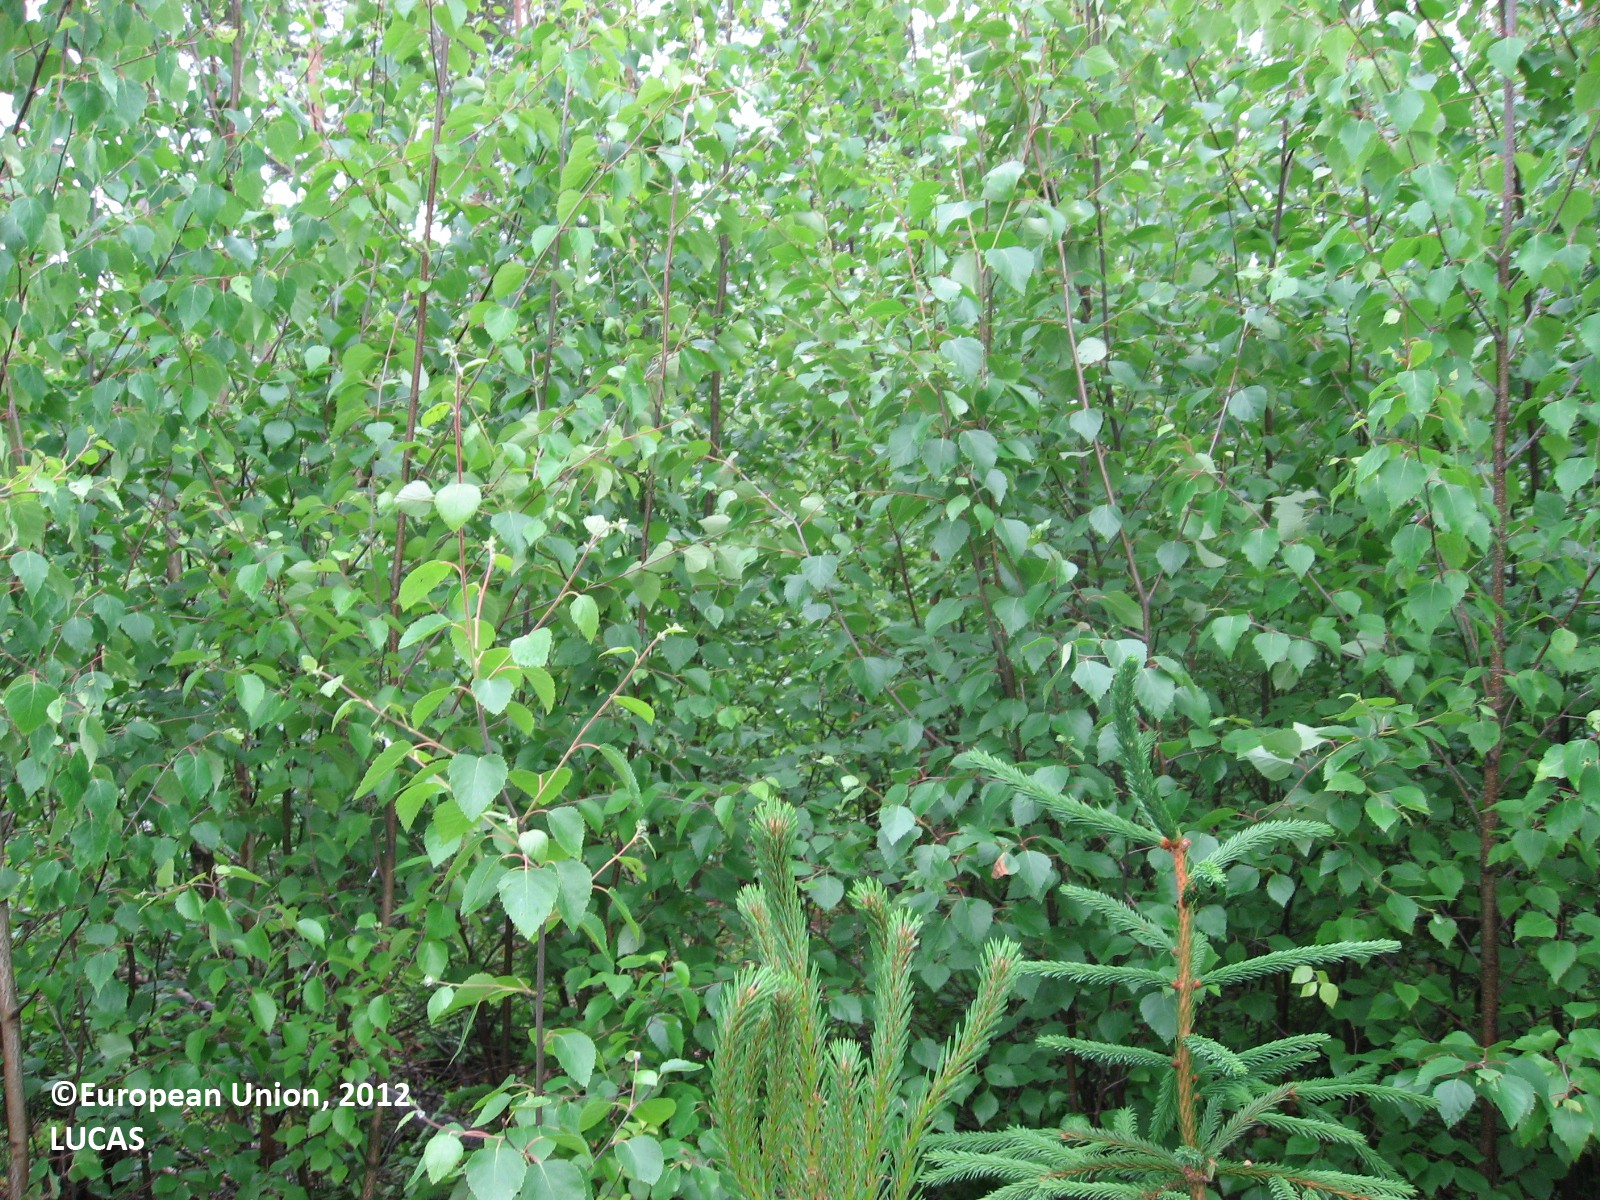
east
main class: Woodland
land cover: Broadleaved woodland
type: boreal forest
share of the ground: > 75 %
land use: Forestry
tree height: > 5 m
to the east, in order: Broadleaved woodland; Other mixed woodland; Ditches and canals; Pine dominated mixed woodland; Rivers and streams; Broadleaved woodland; Ditches and canals; Grassland with sparse tree/shrub cover
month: June
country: FI
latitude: 60.4568
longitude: 26.3144
